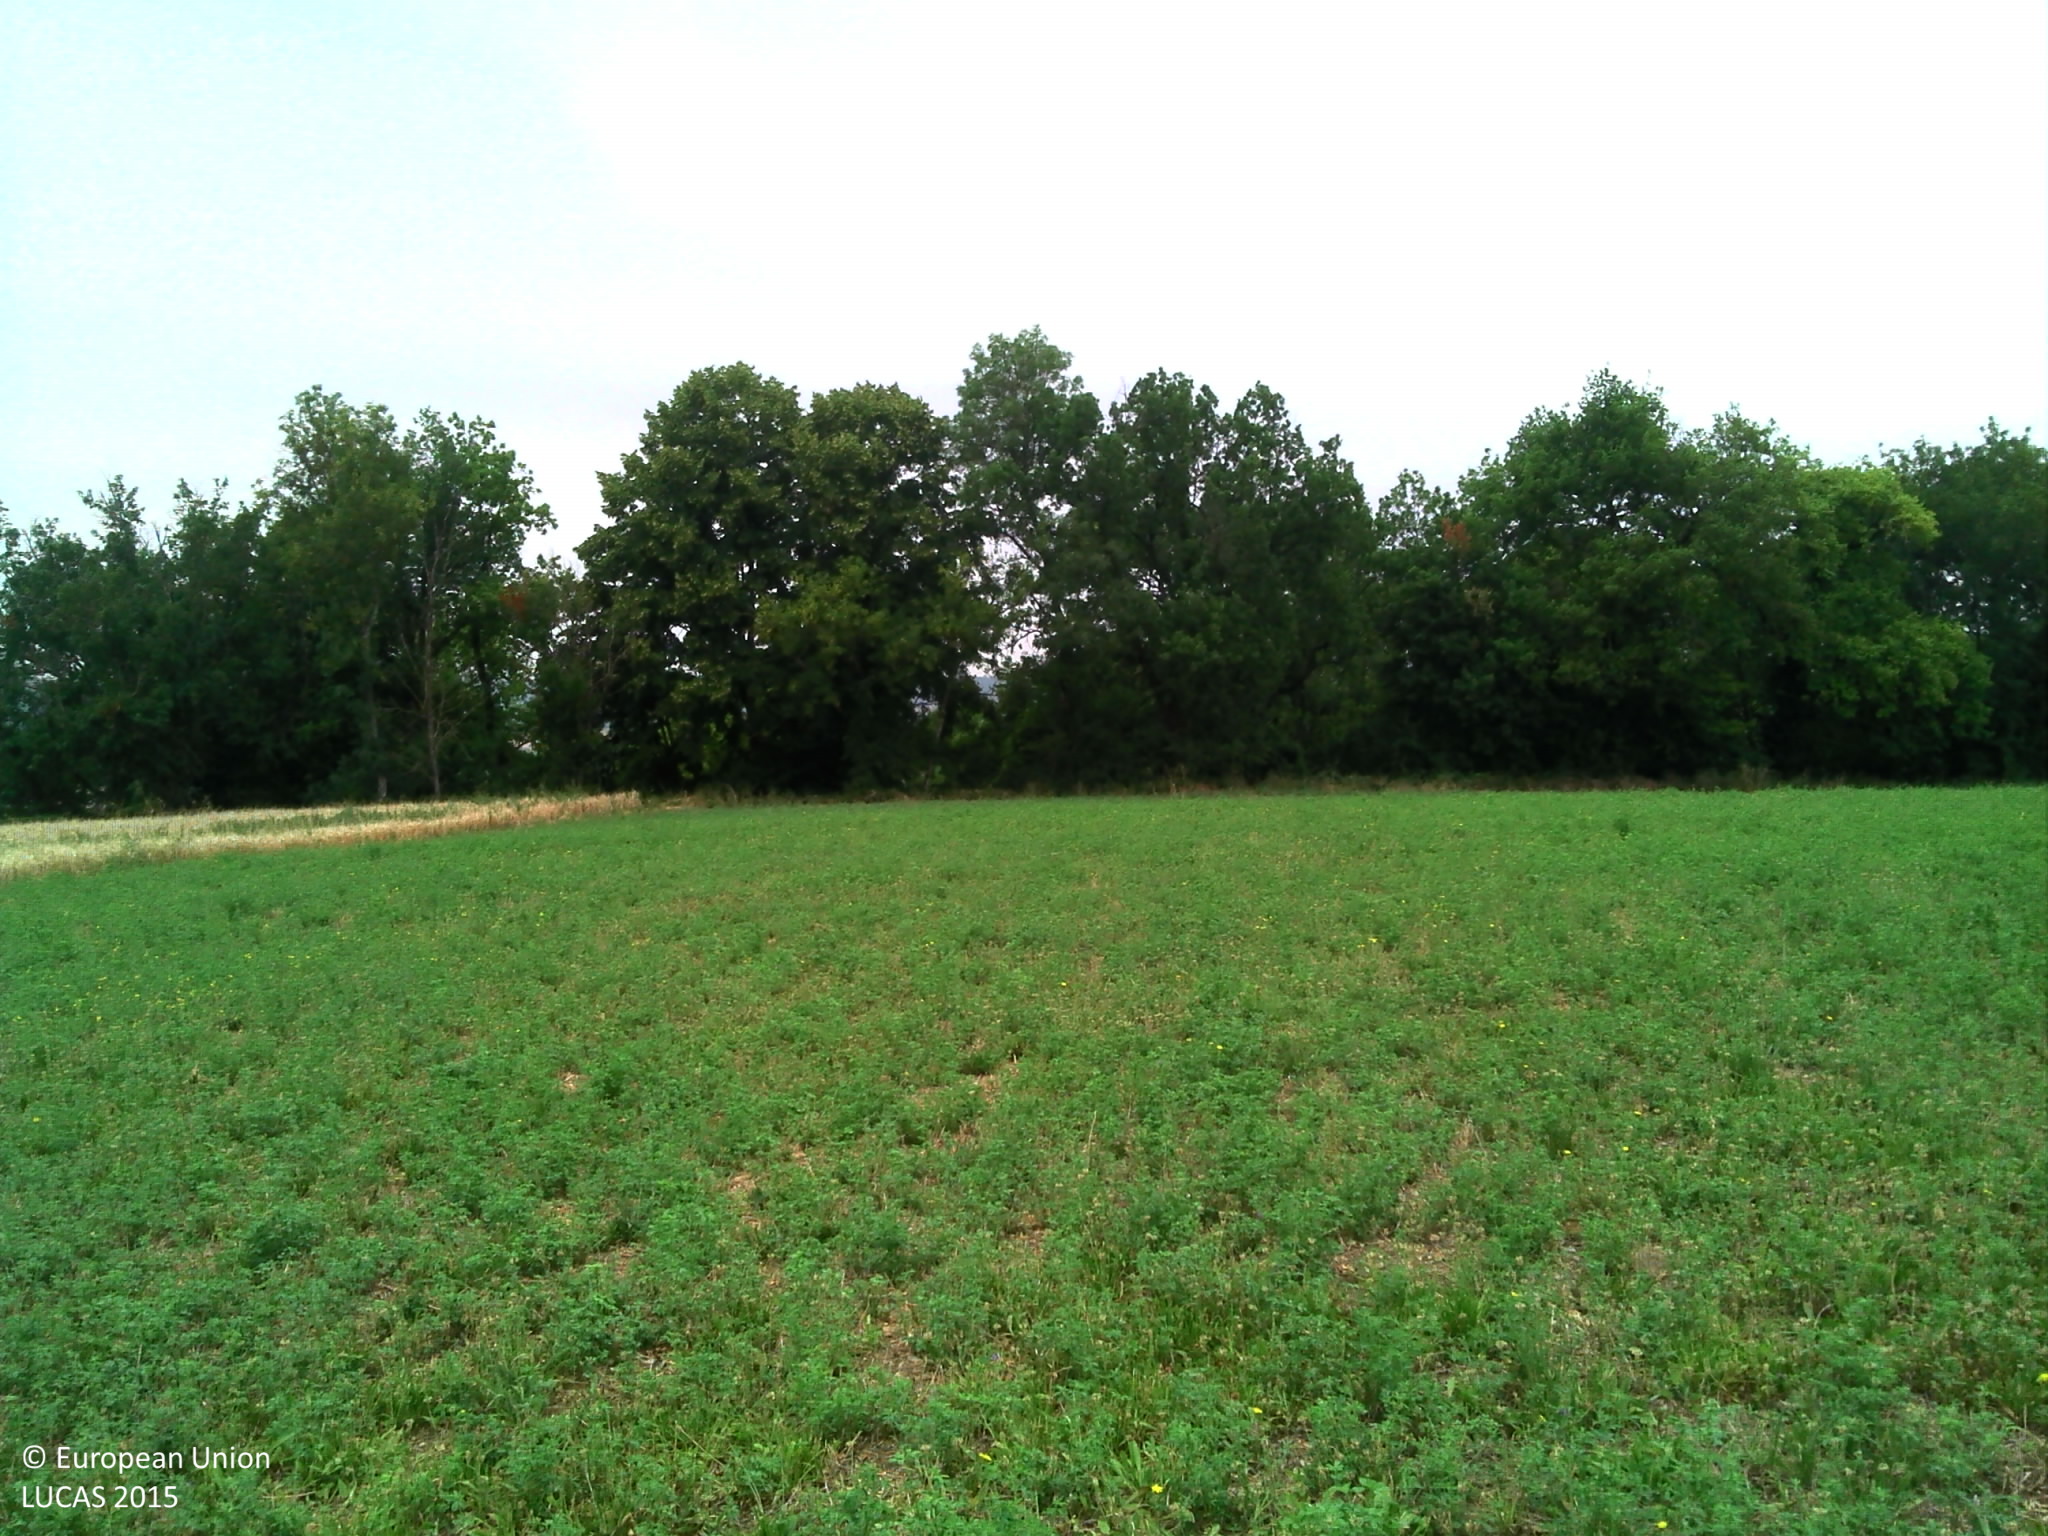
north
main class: Cropland
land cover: Lucerne
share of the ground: > 75 %
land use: Agriculture (excluding fallow land and kitchen gardens)
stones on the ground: 10 - 25 %
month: July
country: FR
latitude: 44.2732
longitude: 0.8625
